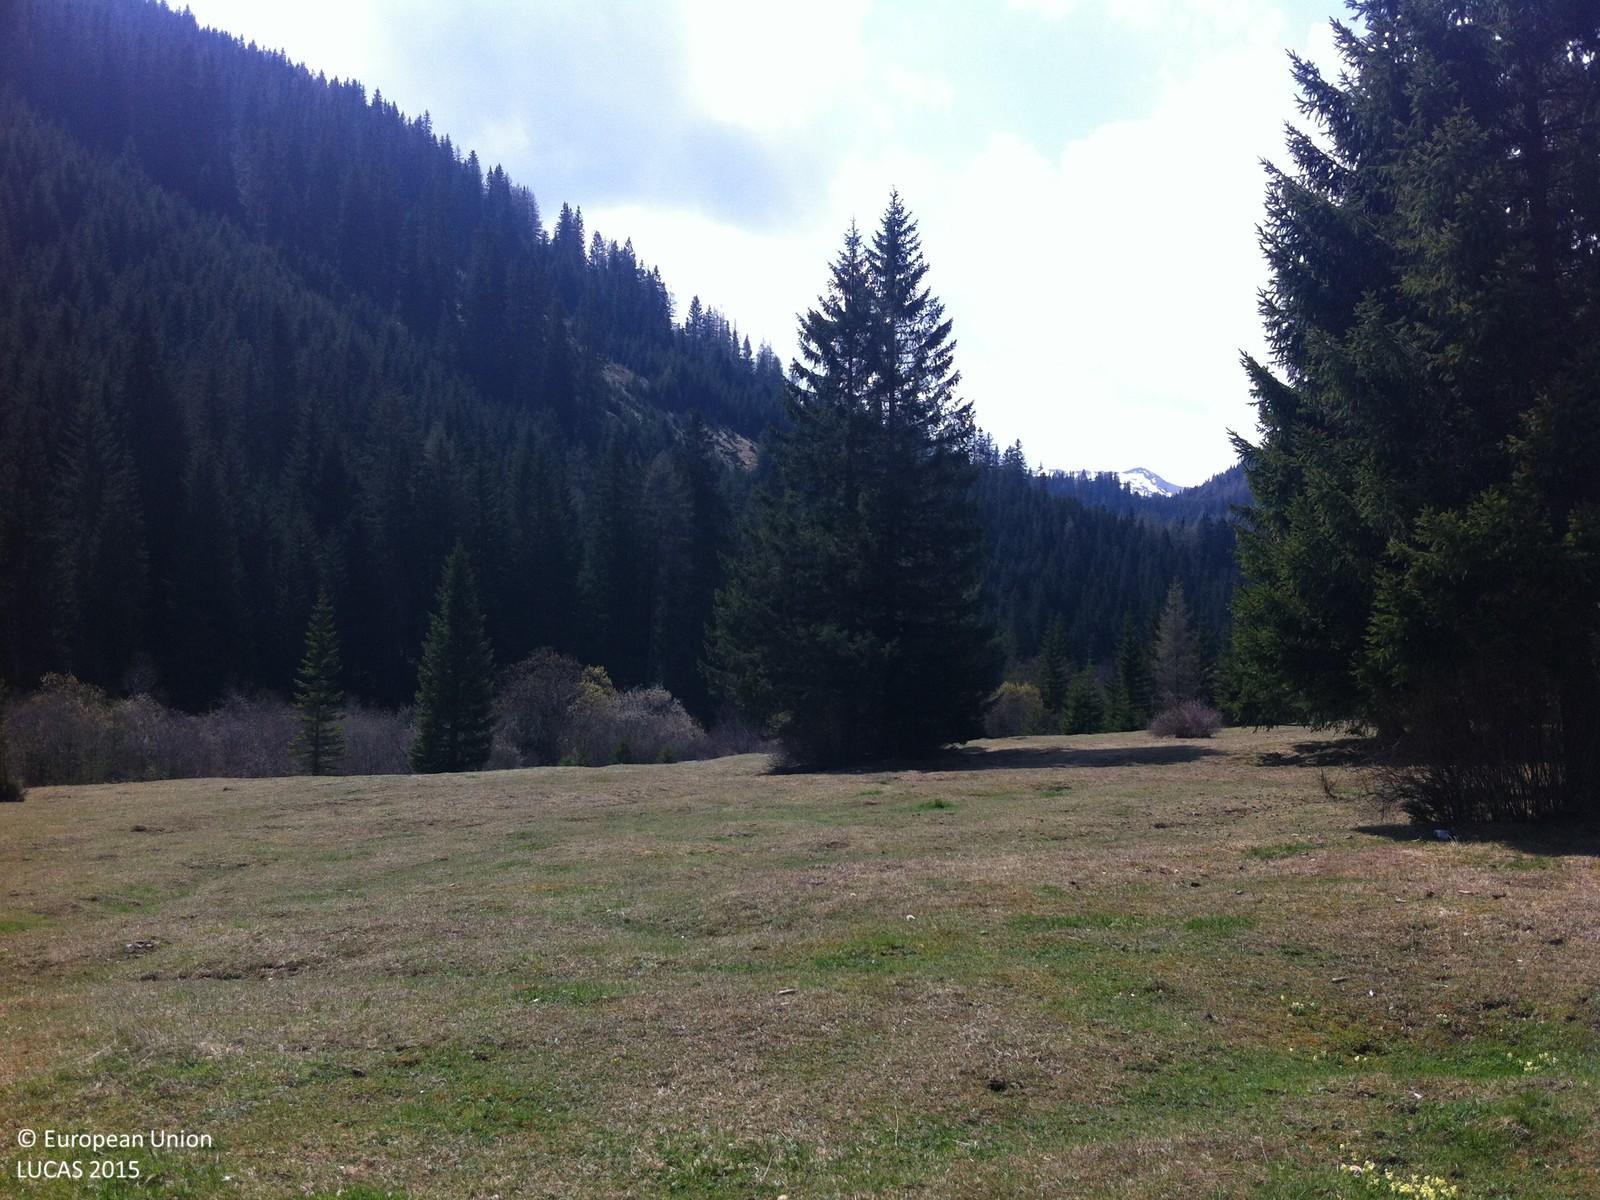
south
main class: Grassland
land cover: Grassland without tree/shrub cover
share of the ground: > 75 %
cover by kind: herbaceous plants 100 %
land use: Agriculture (excluding fallow land and kitchen gardens)
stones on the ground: < 10 %
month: May
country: AT
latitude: 47.0084
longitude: 11.4060
